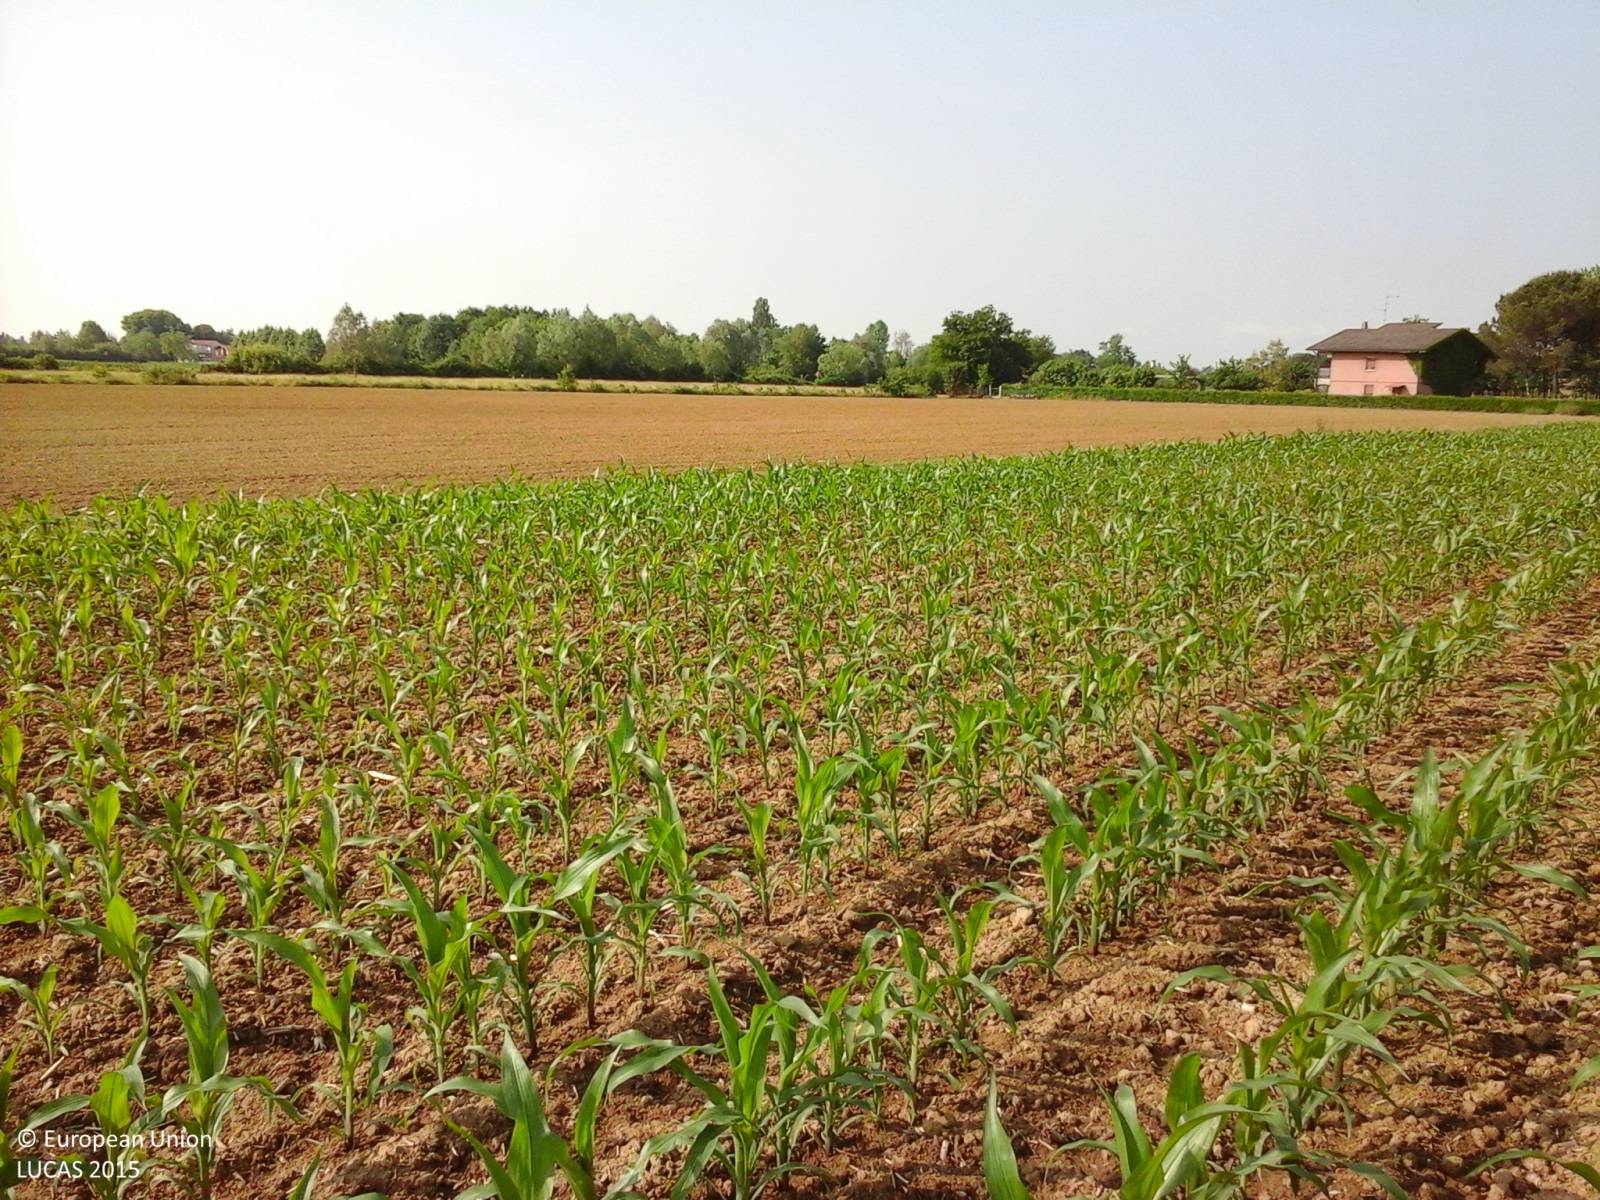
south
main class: Cropland
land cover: Maize
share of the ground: 10 - 25 %
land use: Agriculture (excluding fallow land and kitchen gardens)
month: May
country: IT
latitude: 45.8338
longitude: 13.2274
